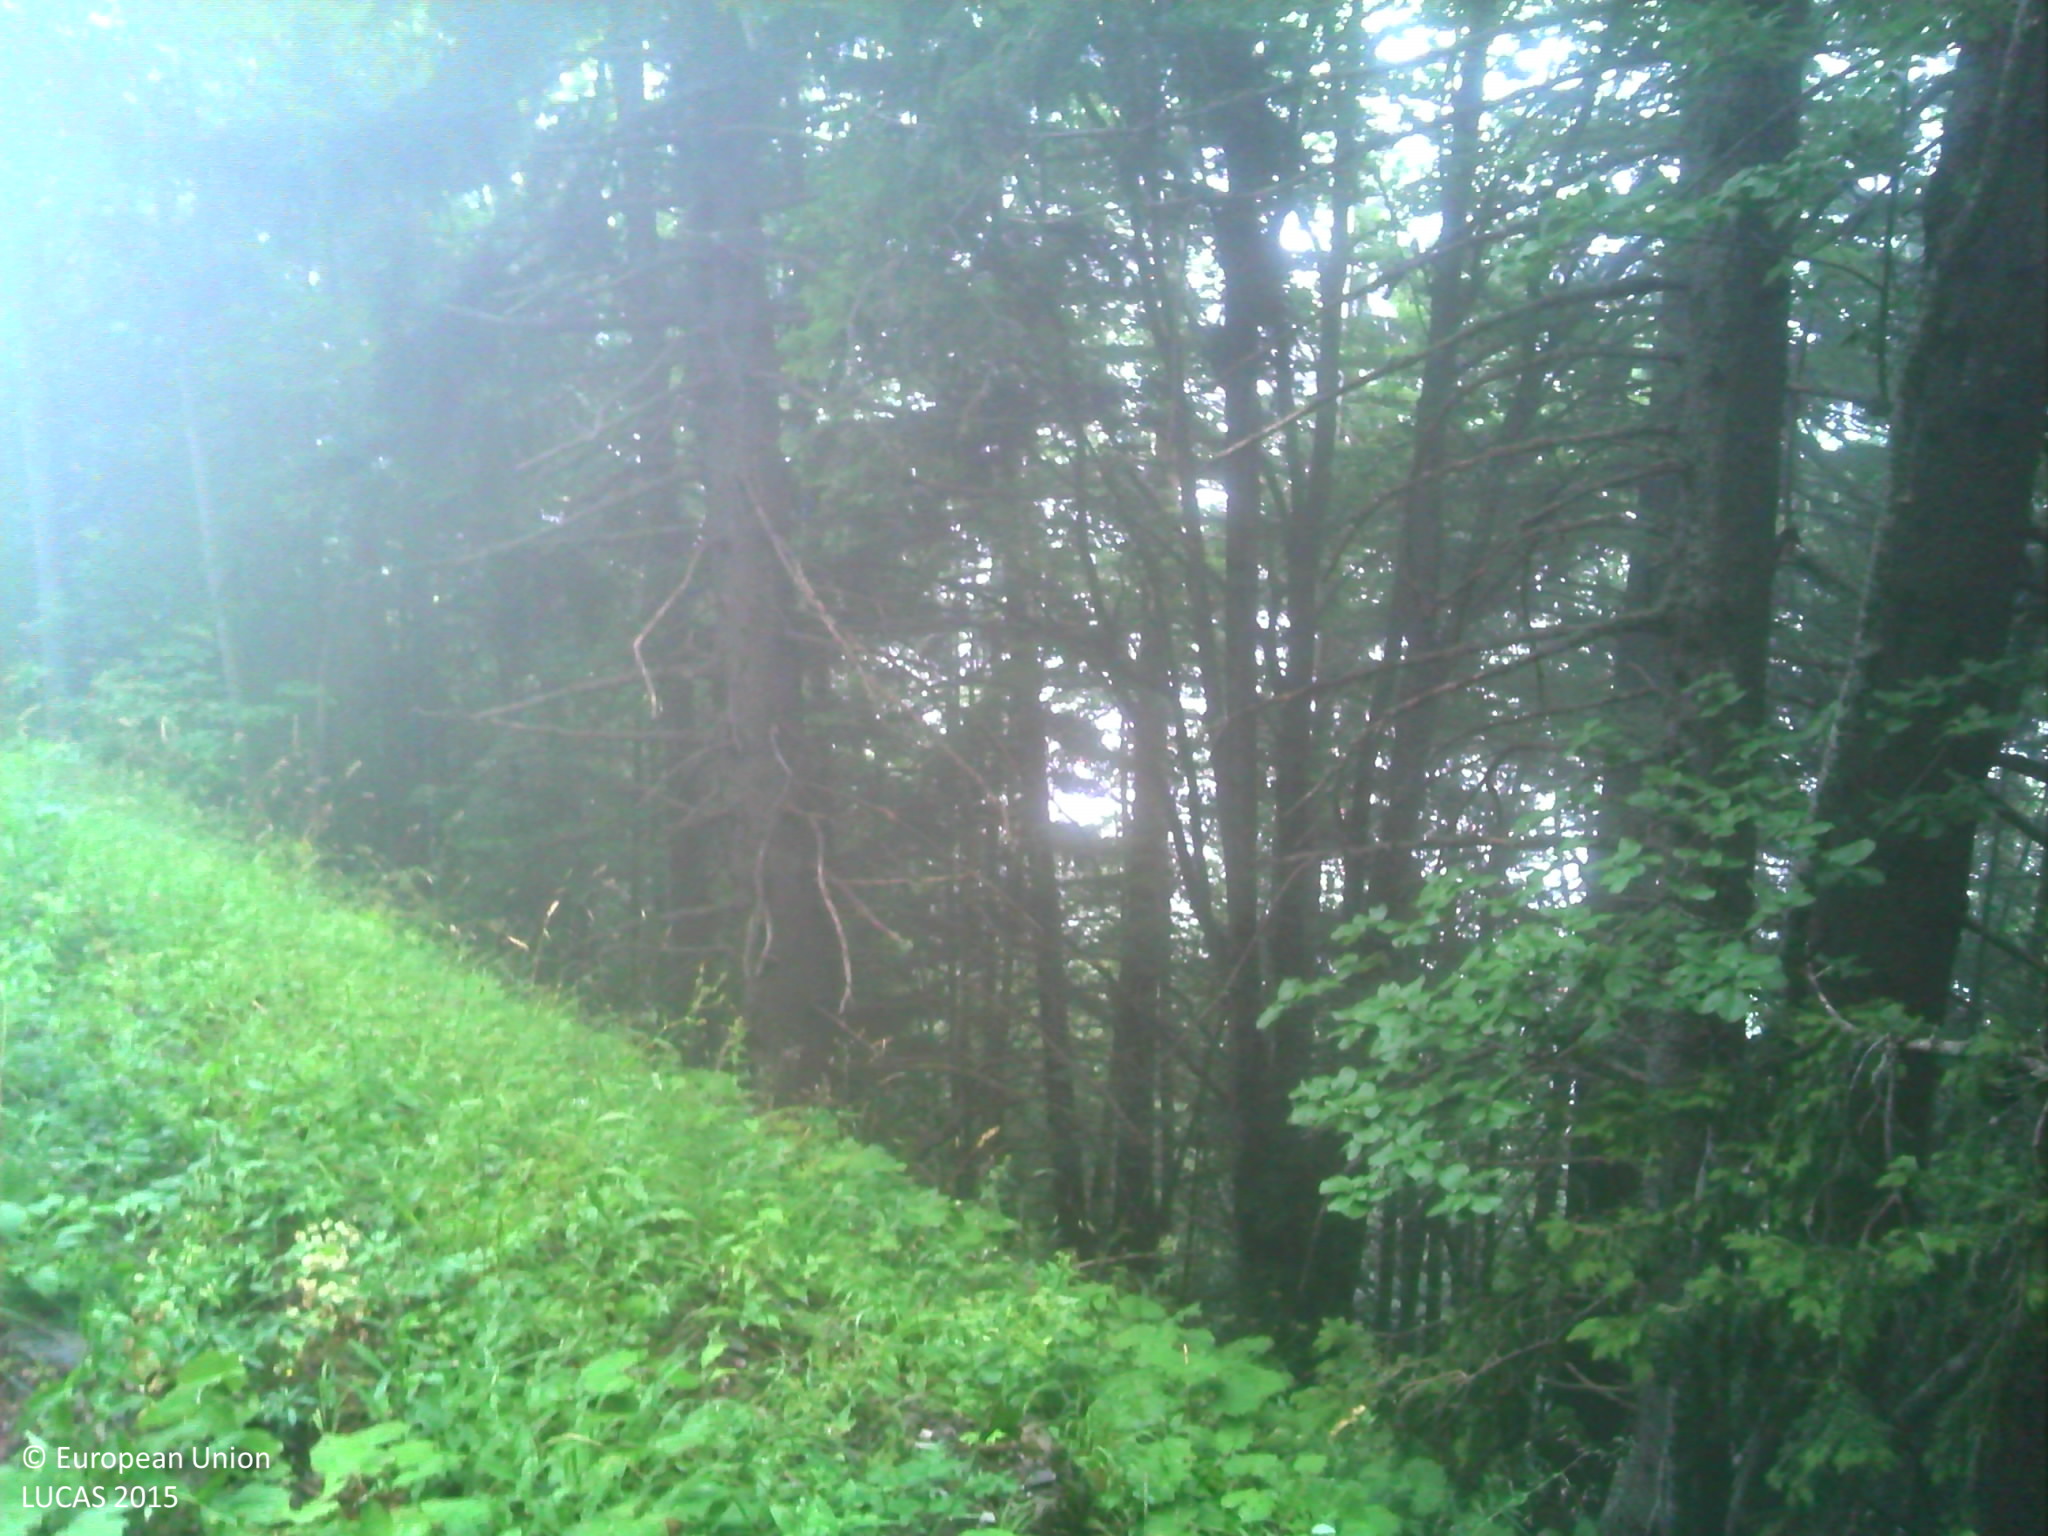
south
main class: Woodland
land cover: Spruce dominated coniferous woodland
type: alpine coniferous forest
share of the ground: > 75 %
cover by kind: coniferous forest trees 70 %, broadleaved forest trees 15 %, herbaceous plants 10 %, lichens and mosses 5 %
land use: Semi-natural and natural areas not in use
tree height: > 5 m
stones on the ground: 25 - 50 %
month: July
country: FR
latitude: 45.9627
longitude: 6.3005
